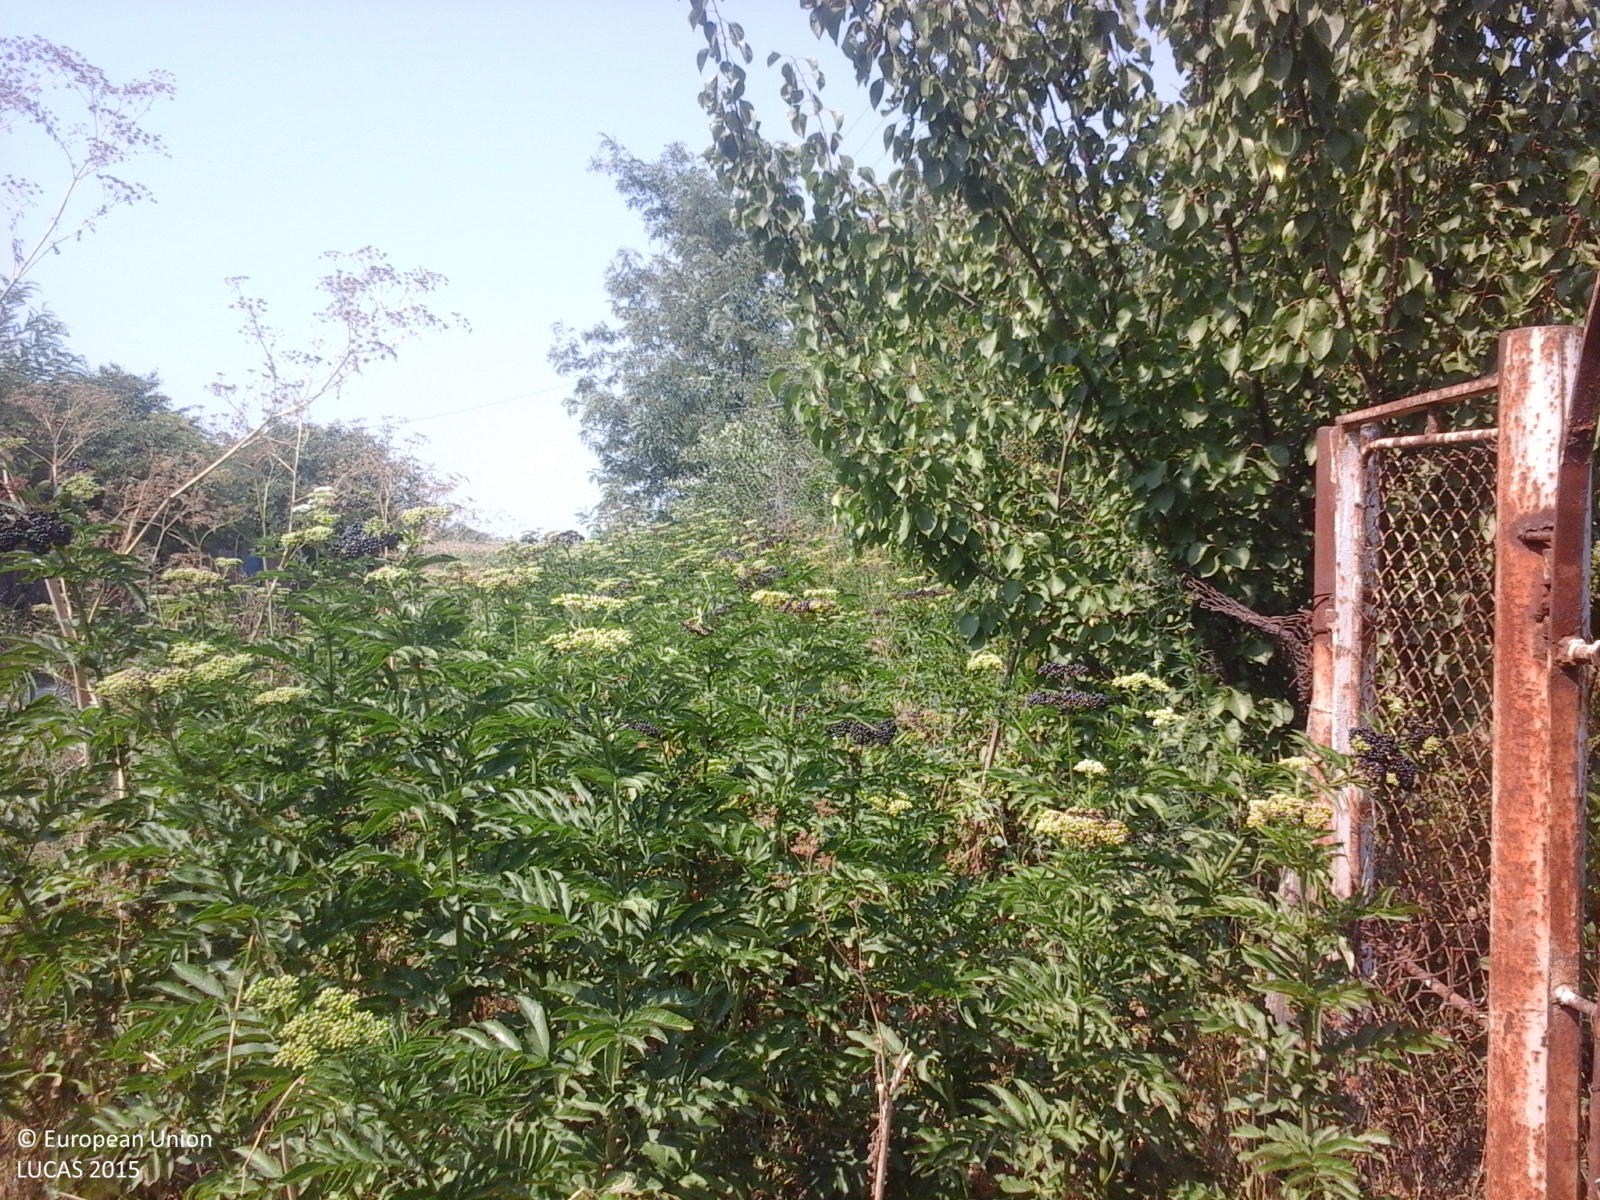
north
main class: Cropland
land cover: Apple fruit
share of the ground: > 75 %
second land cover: Grassland without tree/shrub cover
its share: > 75 %
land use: Kitchen garden
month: July
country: RO
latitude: 45.4473
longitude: 27.8198
